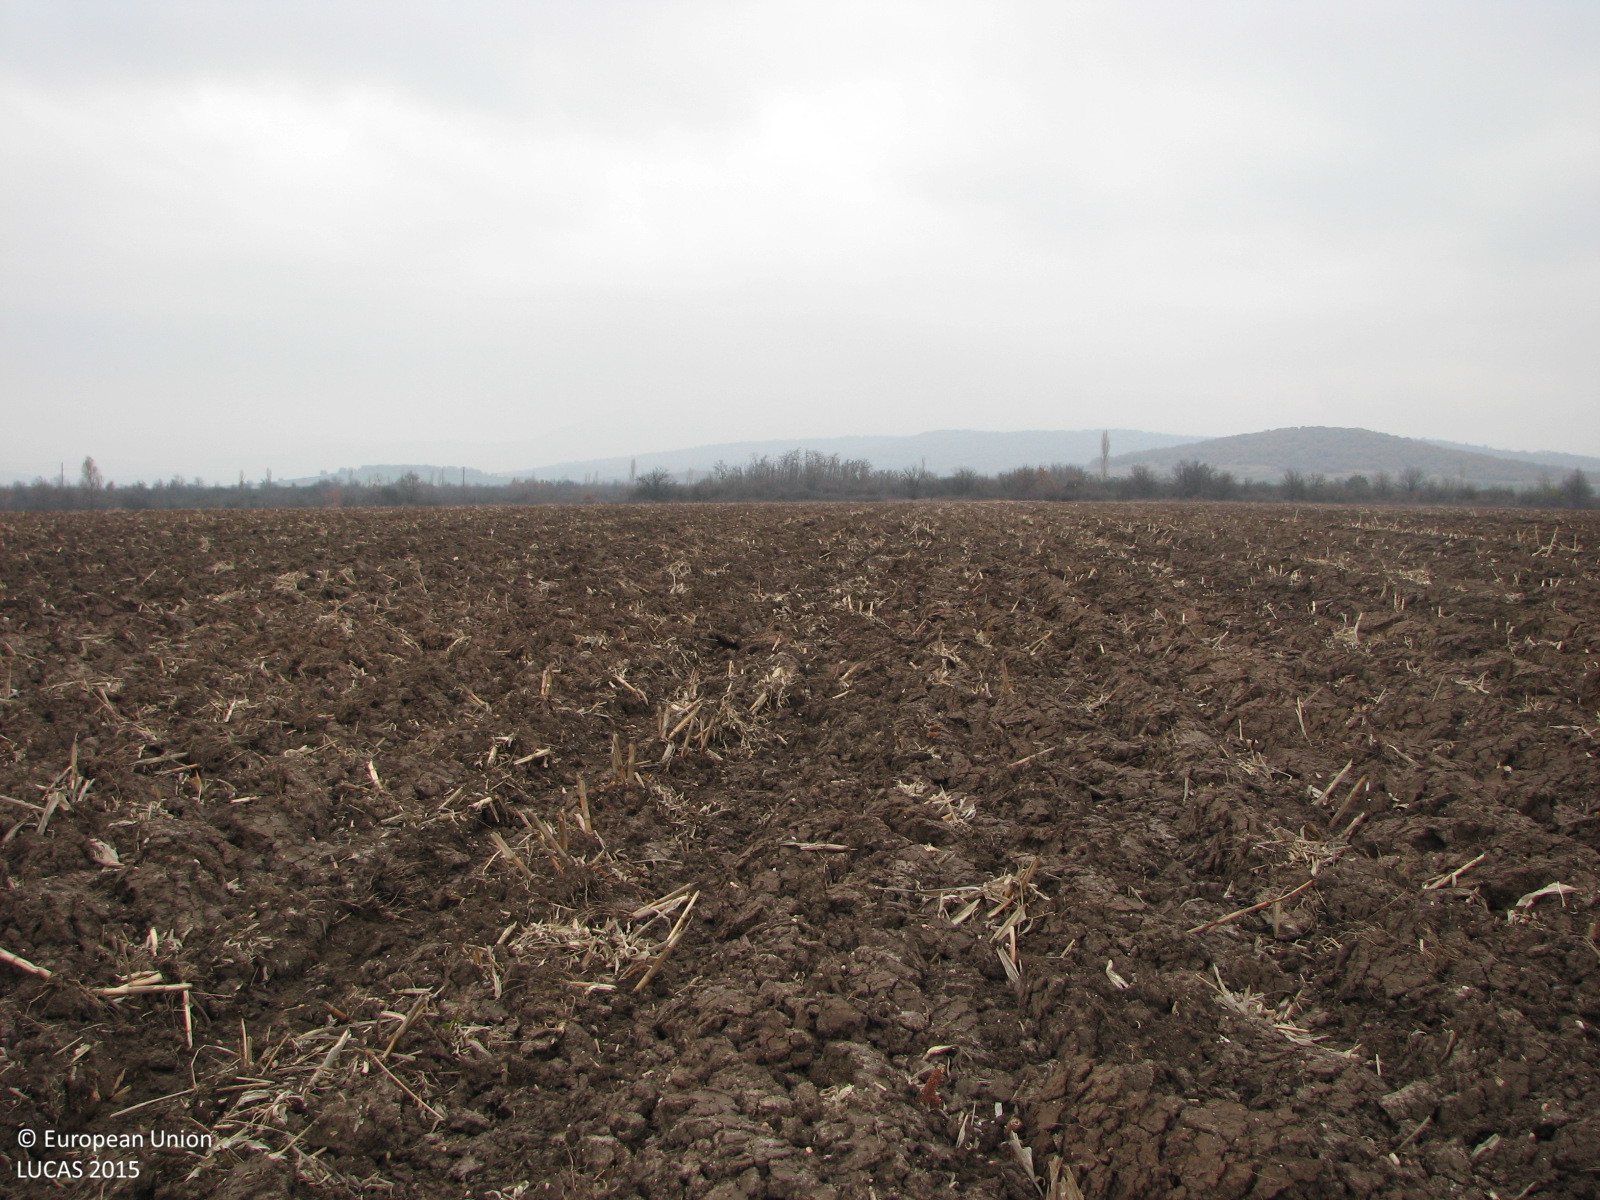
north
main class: Cropland
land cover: Maize
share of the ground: < 10 %
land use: Agriculture (excluding fallow land and kitchen gardens)
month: December
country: BG
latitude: 42.3932
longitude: 24.9885
